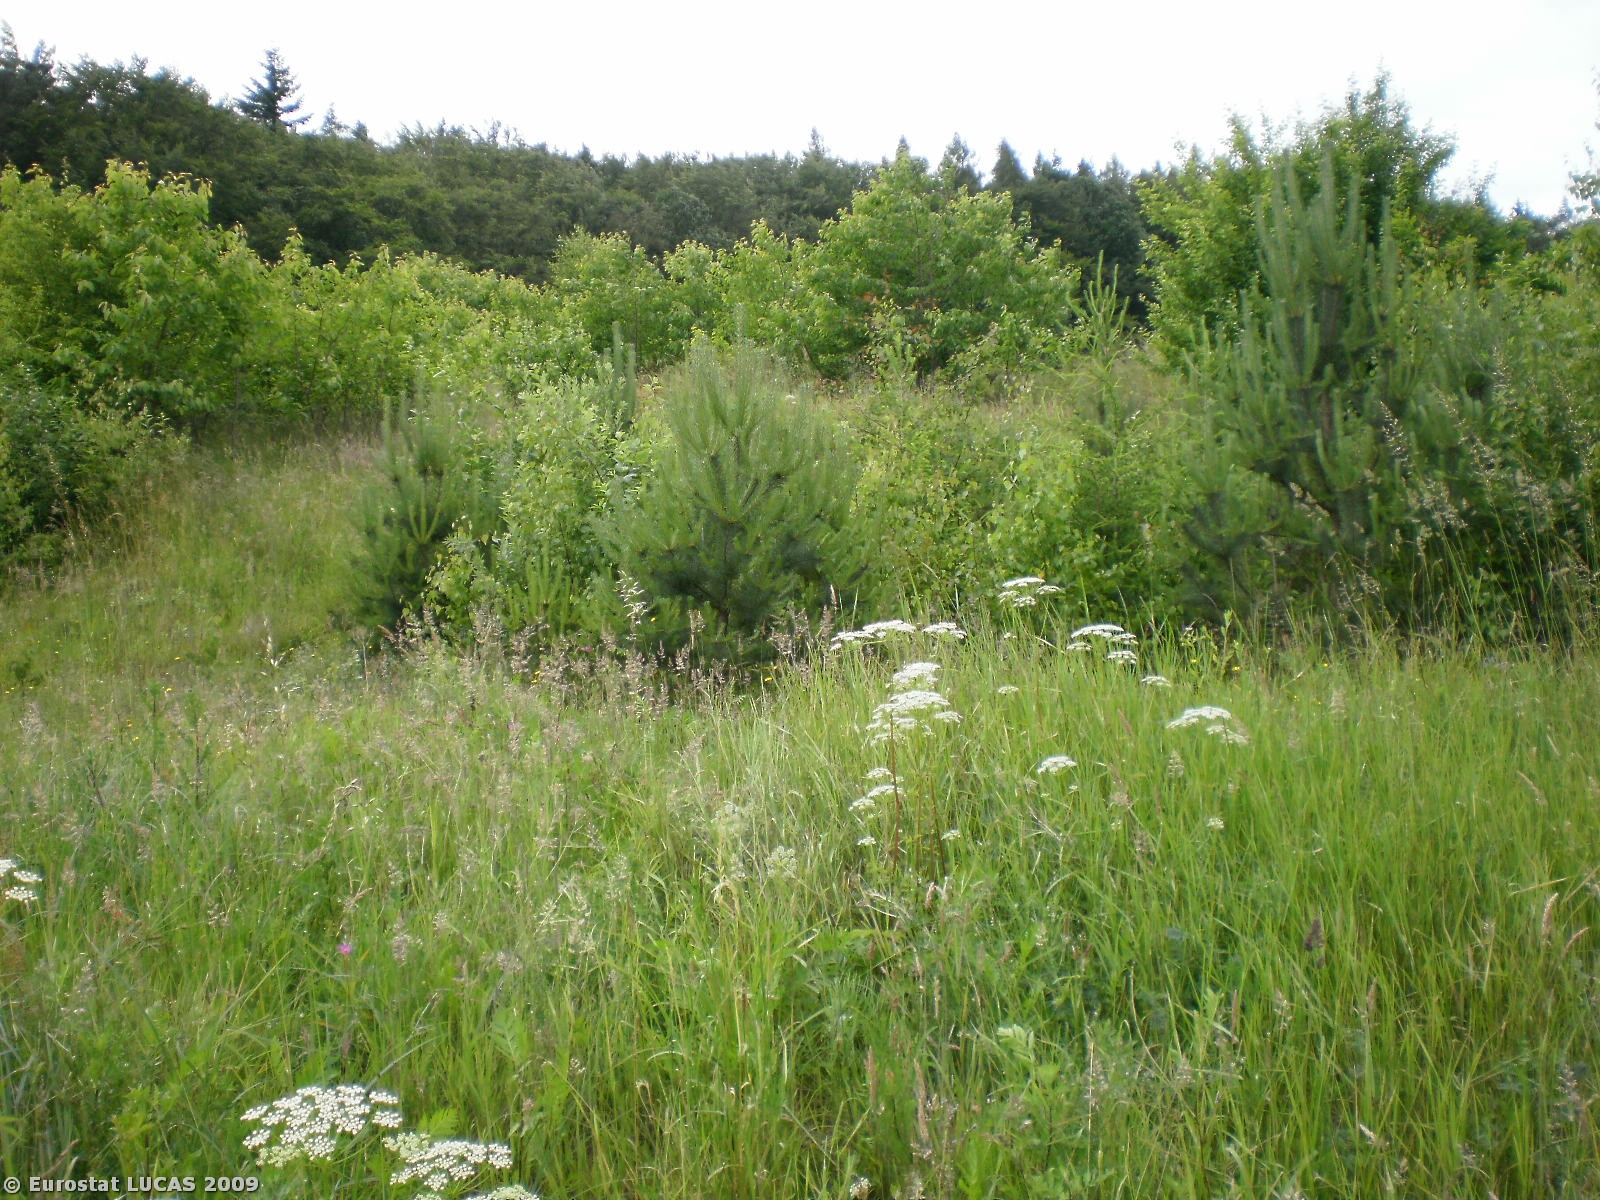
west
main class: Grassland
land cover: Grassland with sparse tree/shrub cover
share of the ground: > 75 %
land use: Unused
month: June
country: PL
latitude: 54.4597
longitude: 18.4858
